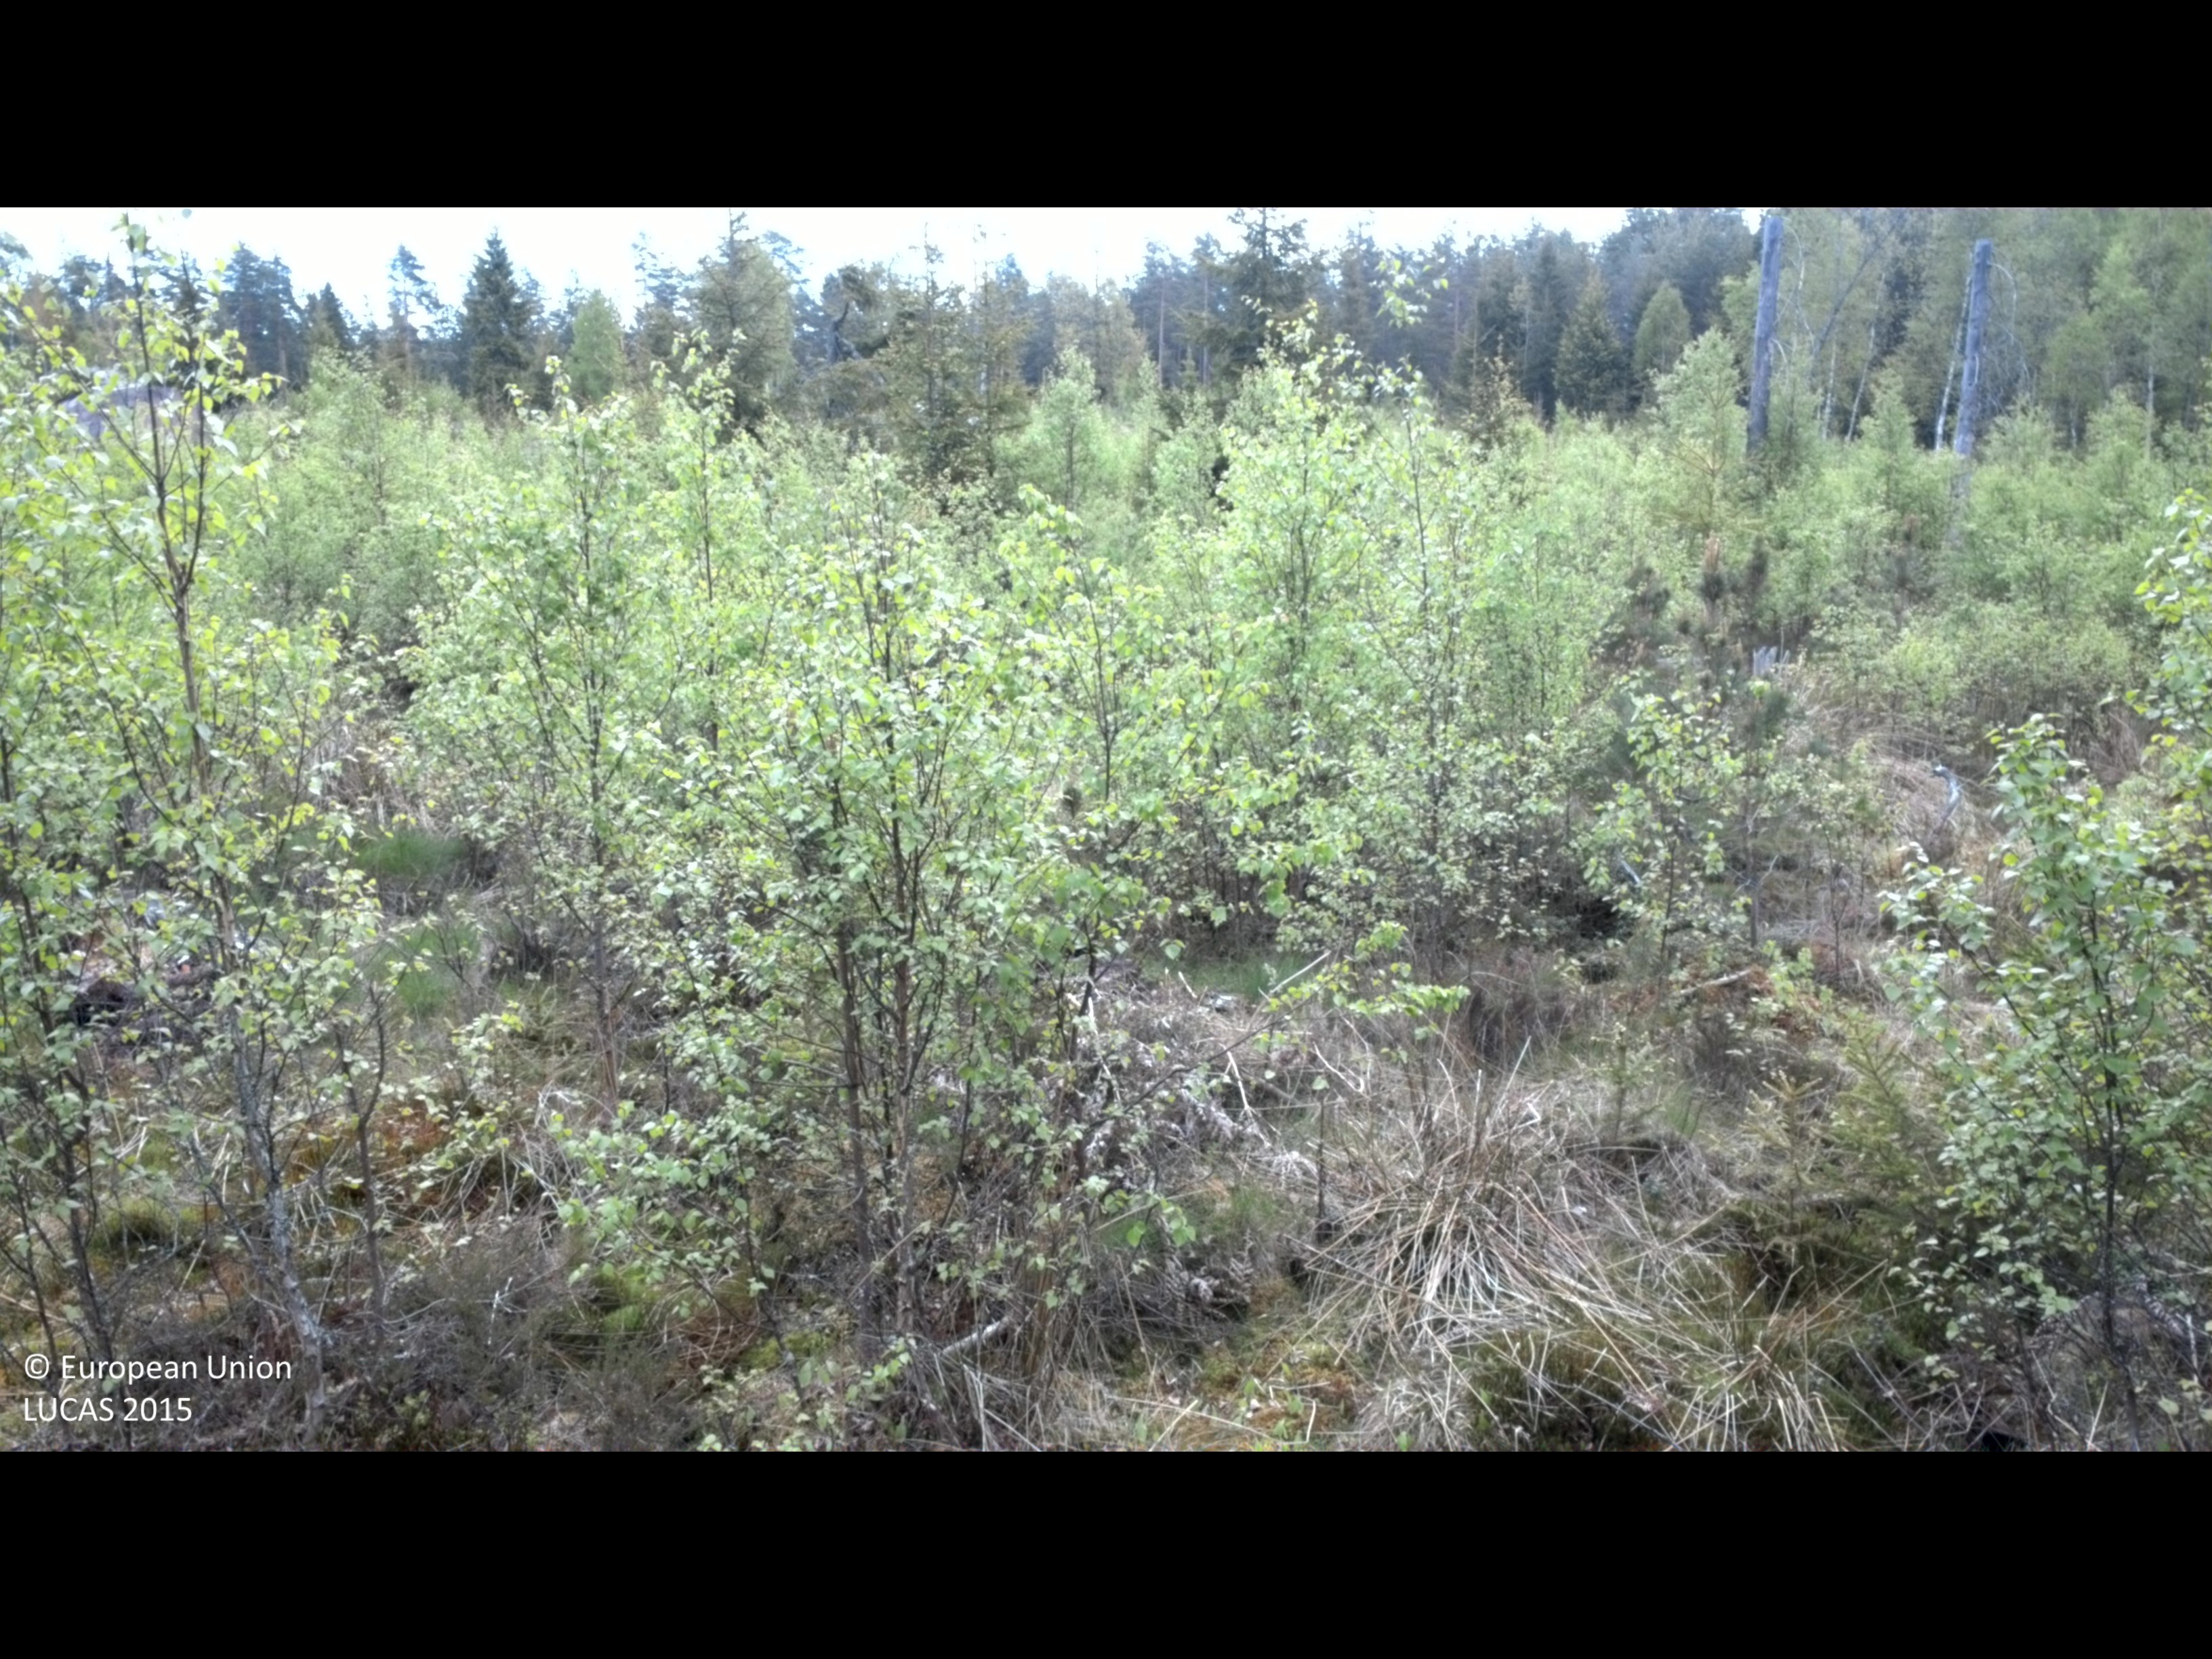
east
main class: Woodland
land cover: Spruce dominated coniferous woodland
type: boreal forest
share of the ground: > 75 %
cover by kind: coniferous forest trees 60 %, broadleaved forest trees 20 %, shrubs 20 %
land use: Forestry
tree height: < 5 m
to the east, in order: Spruce dominated coniferous woodland; Broadleaved woodland; Spruce dominated mixed woodland; Pine dominated coniferous woodland; Spruce dominated coniferous woodland
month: May
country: SE
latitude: 57.4177
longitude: 16.0086
